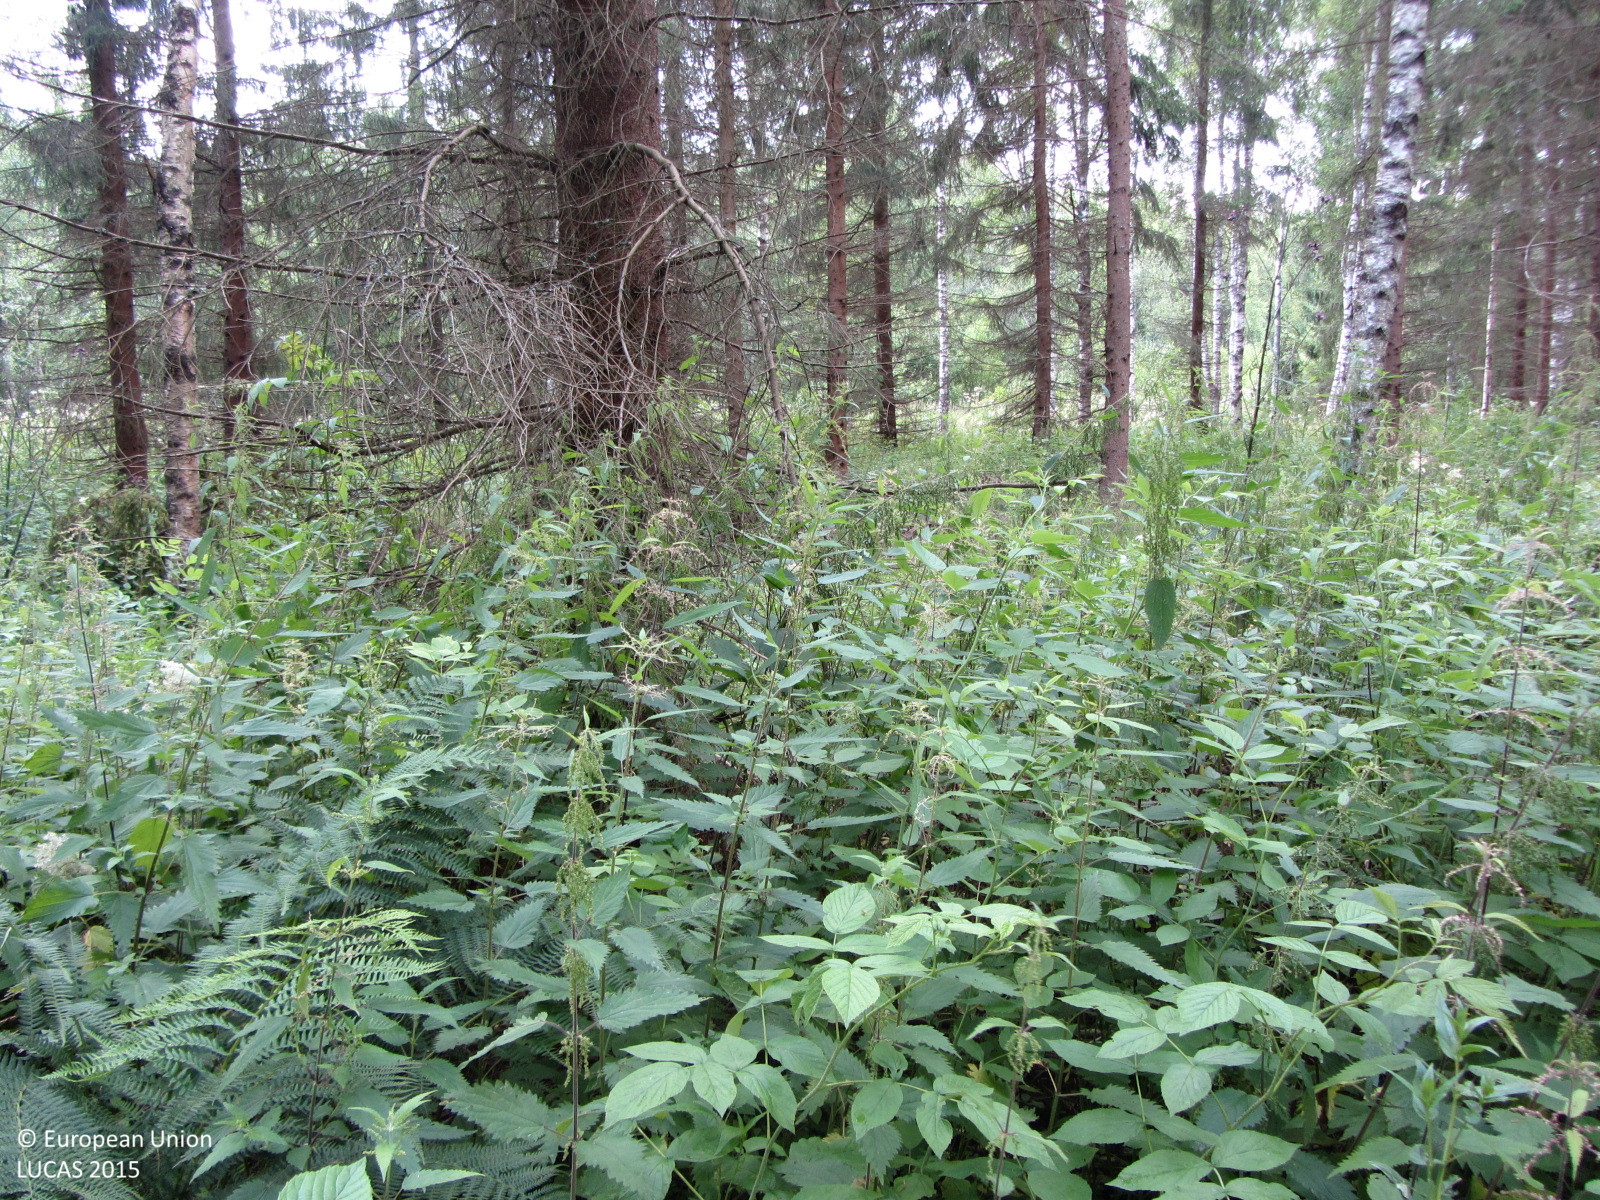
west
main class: Woodland
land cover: Spruce dominated mixed woodland
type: boreal forest
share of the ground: 25 - 50 %
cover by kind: herbaceous plants 55 %, coniferous forest trees 30 %, broadleaved forest trees 15 %
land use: Forestry
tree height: > 5 m
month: July
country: FI
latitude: 60.7033
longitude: 24.7481
